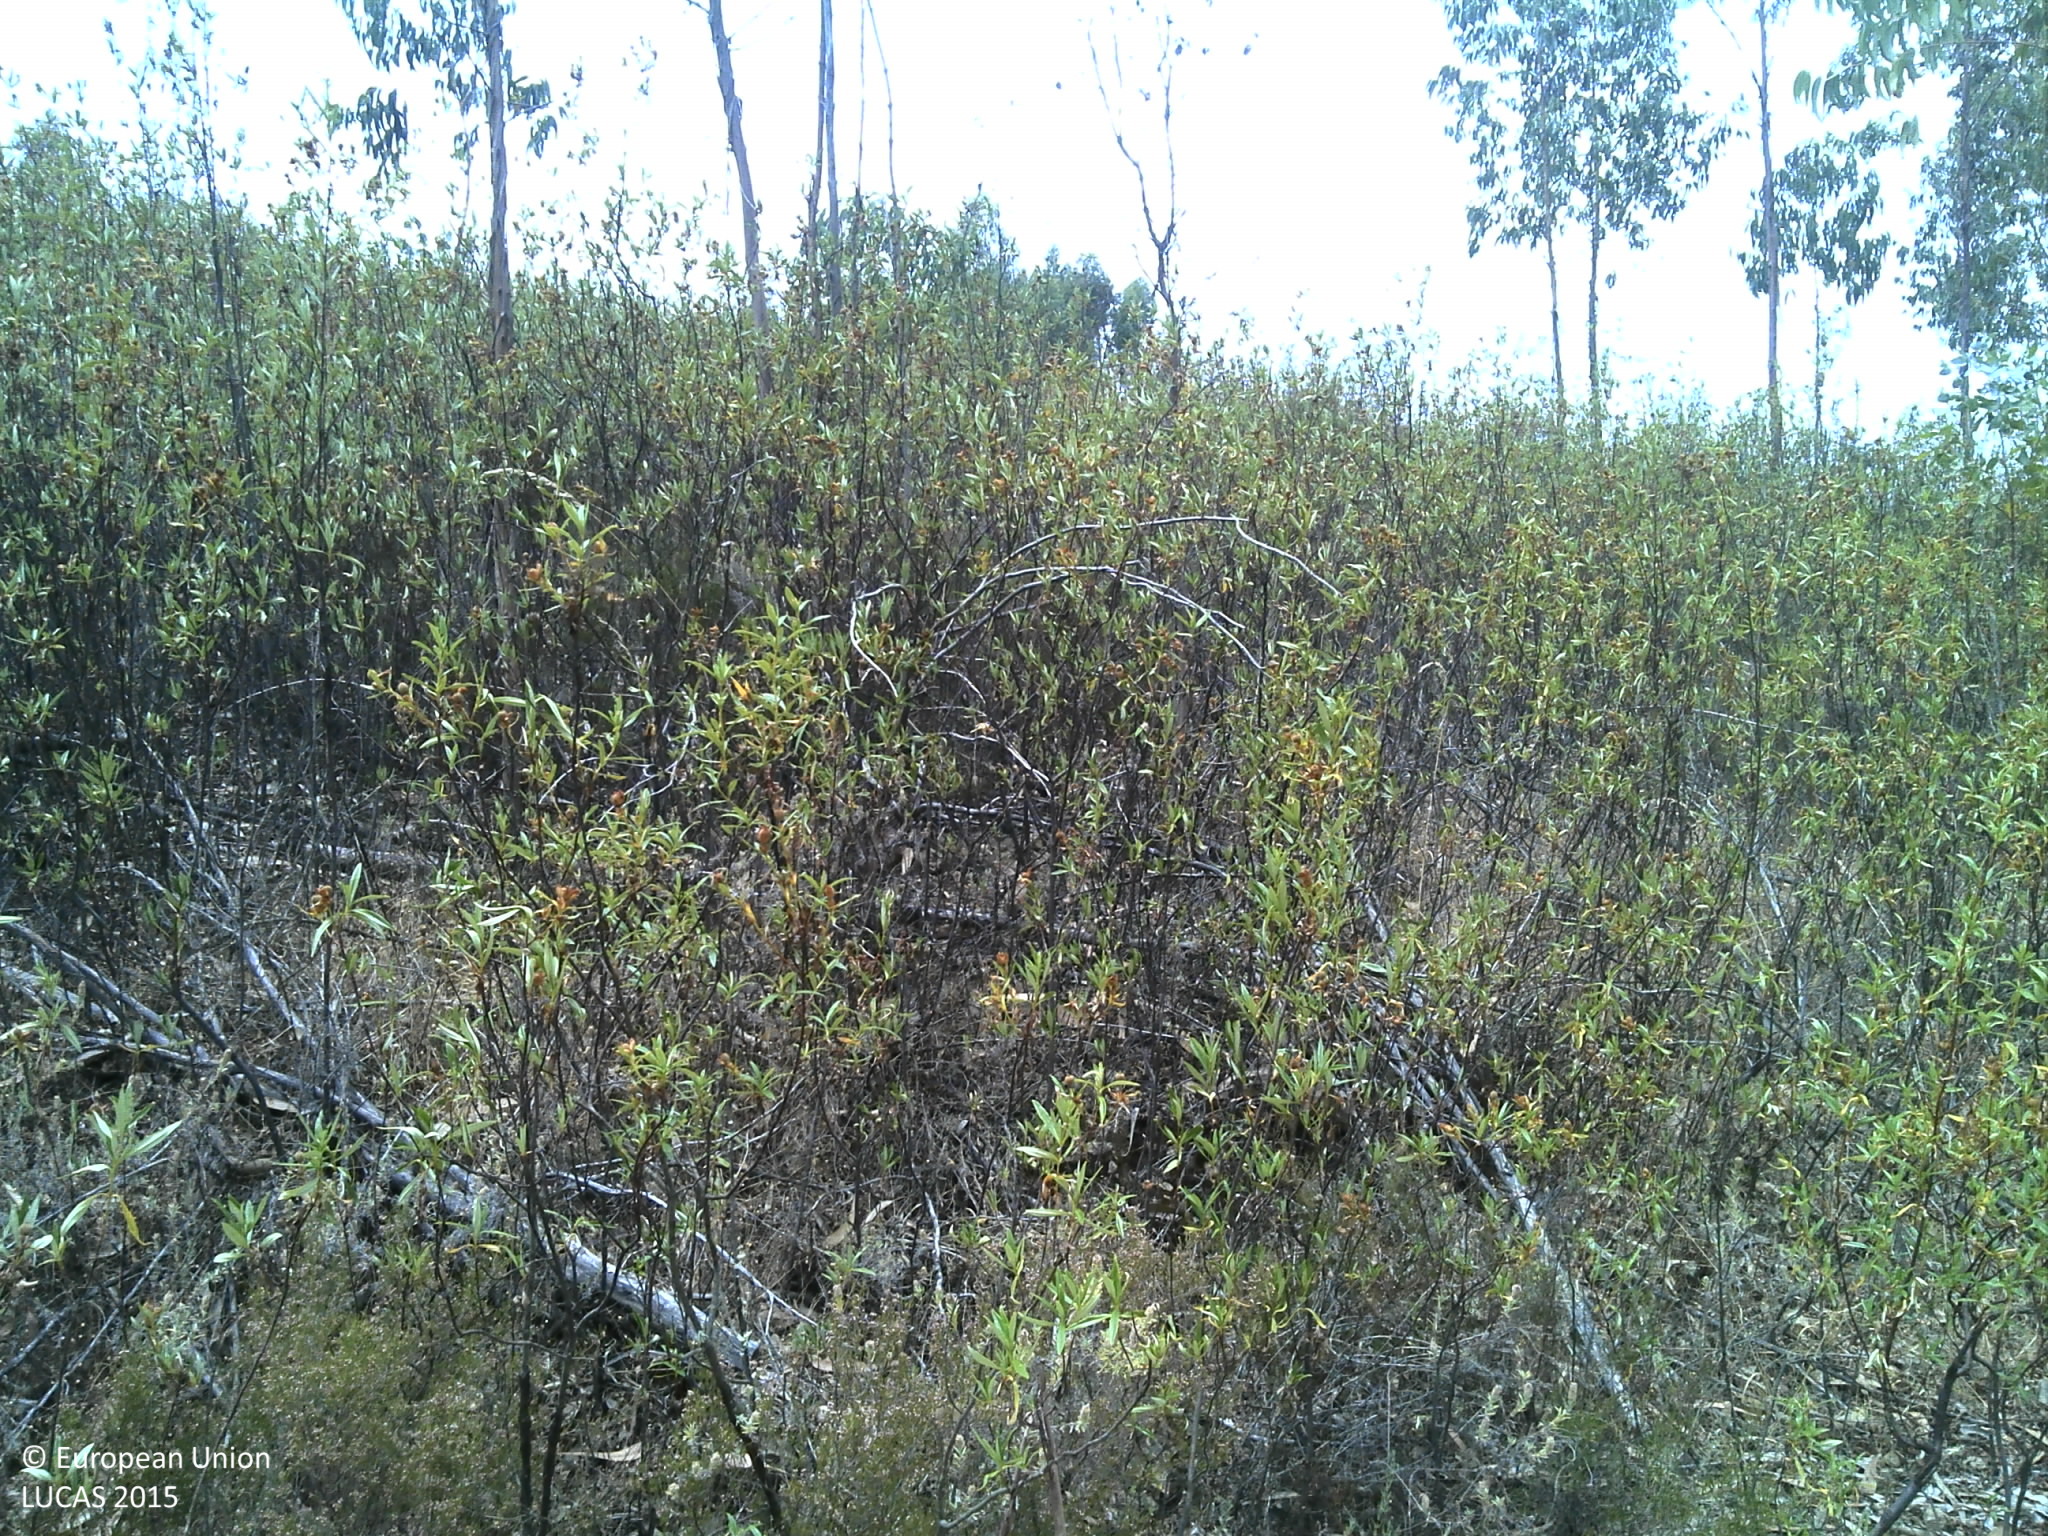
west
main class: Shrubland
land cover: Shrubland with sparse tree cover
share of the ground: > 75 %
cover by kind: shrubs 85 %, broadleaved forest trees 5 %, consolidated bare surface 5 %, unconsolidated bare surface 5 %
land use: Abandoned areas
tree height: > 5 m
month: July
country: PT
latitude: 39.5674
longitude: -8.0935
